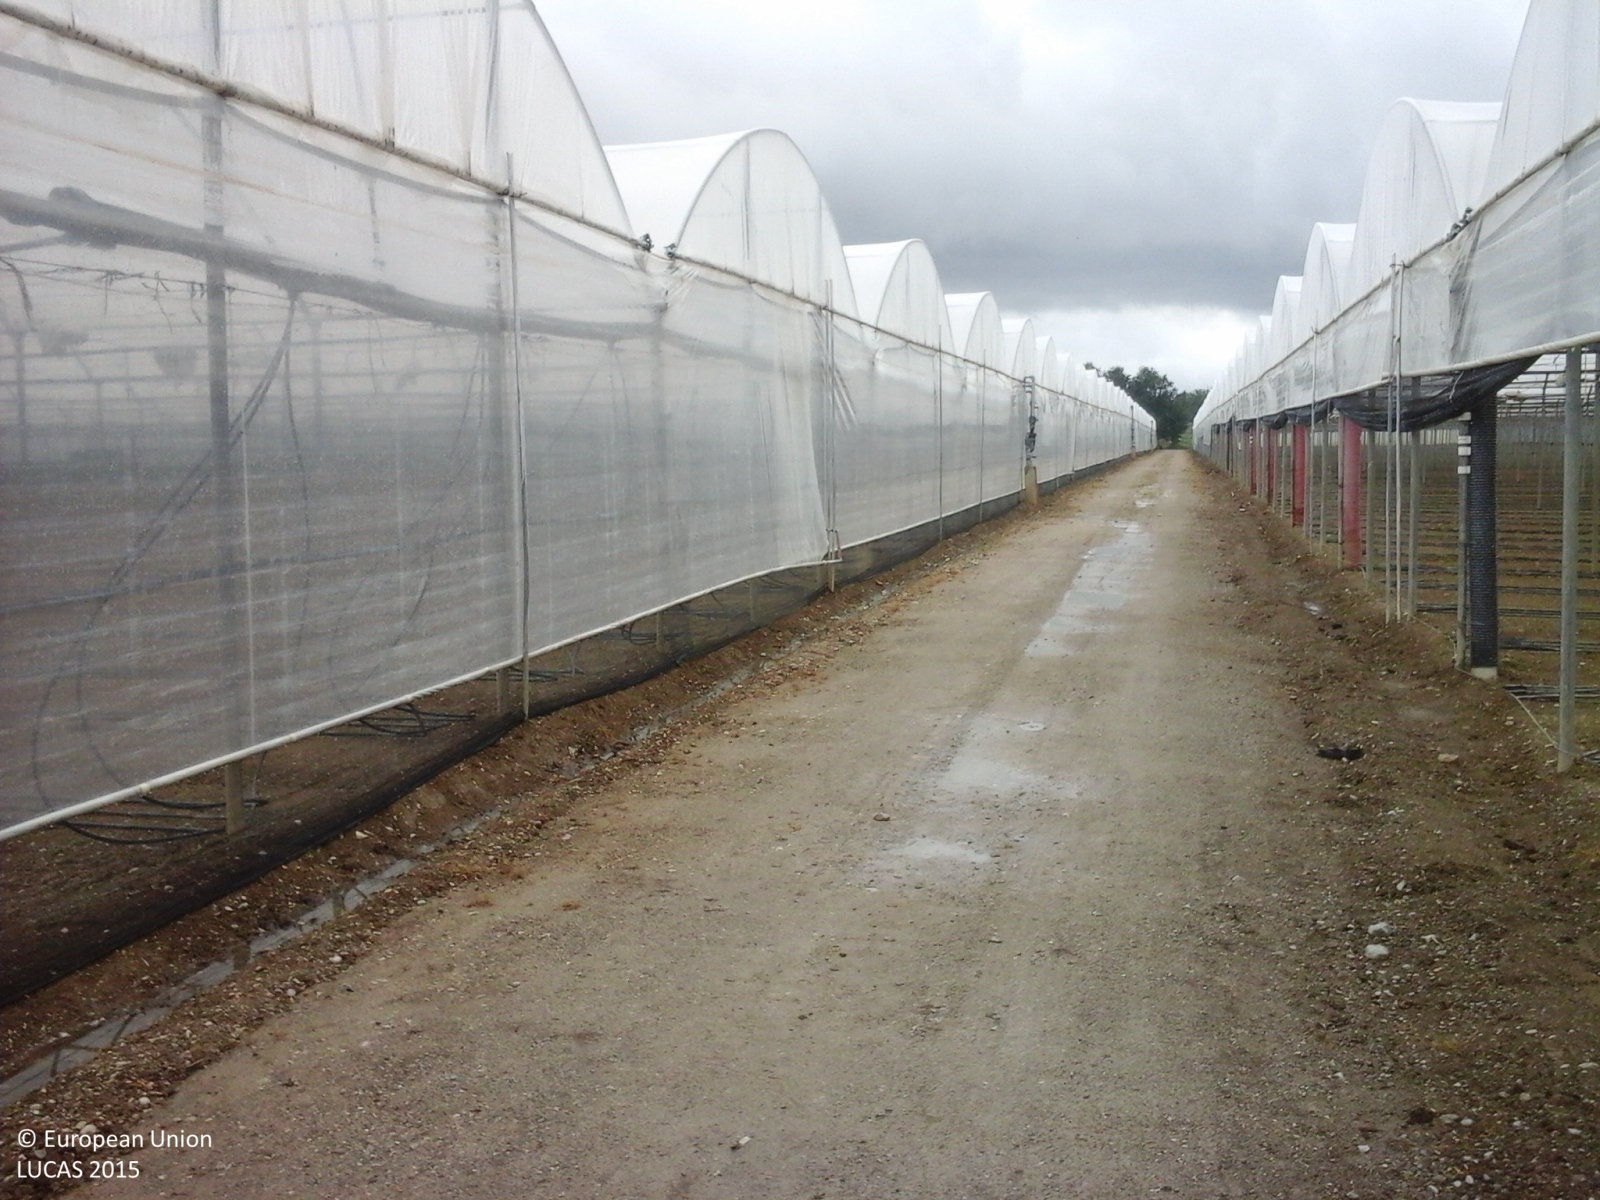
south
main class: Artificial land
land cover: Greenhouses
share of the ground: > 75 %
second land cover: Other fresh vegetables
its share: > 75 %
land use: Agriculture (excluding fallow land and kitchen gardens)
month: May
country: IT
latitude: 40.5725
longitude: 15.0465
